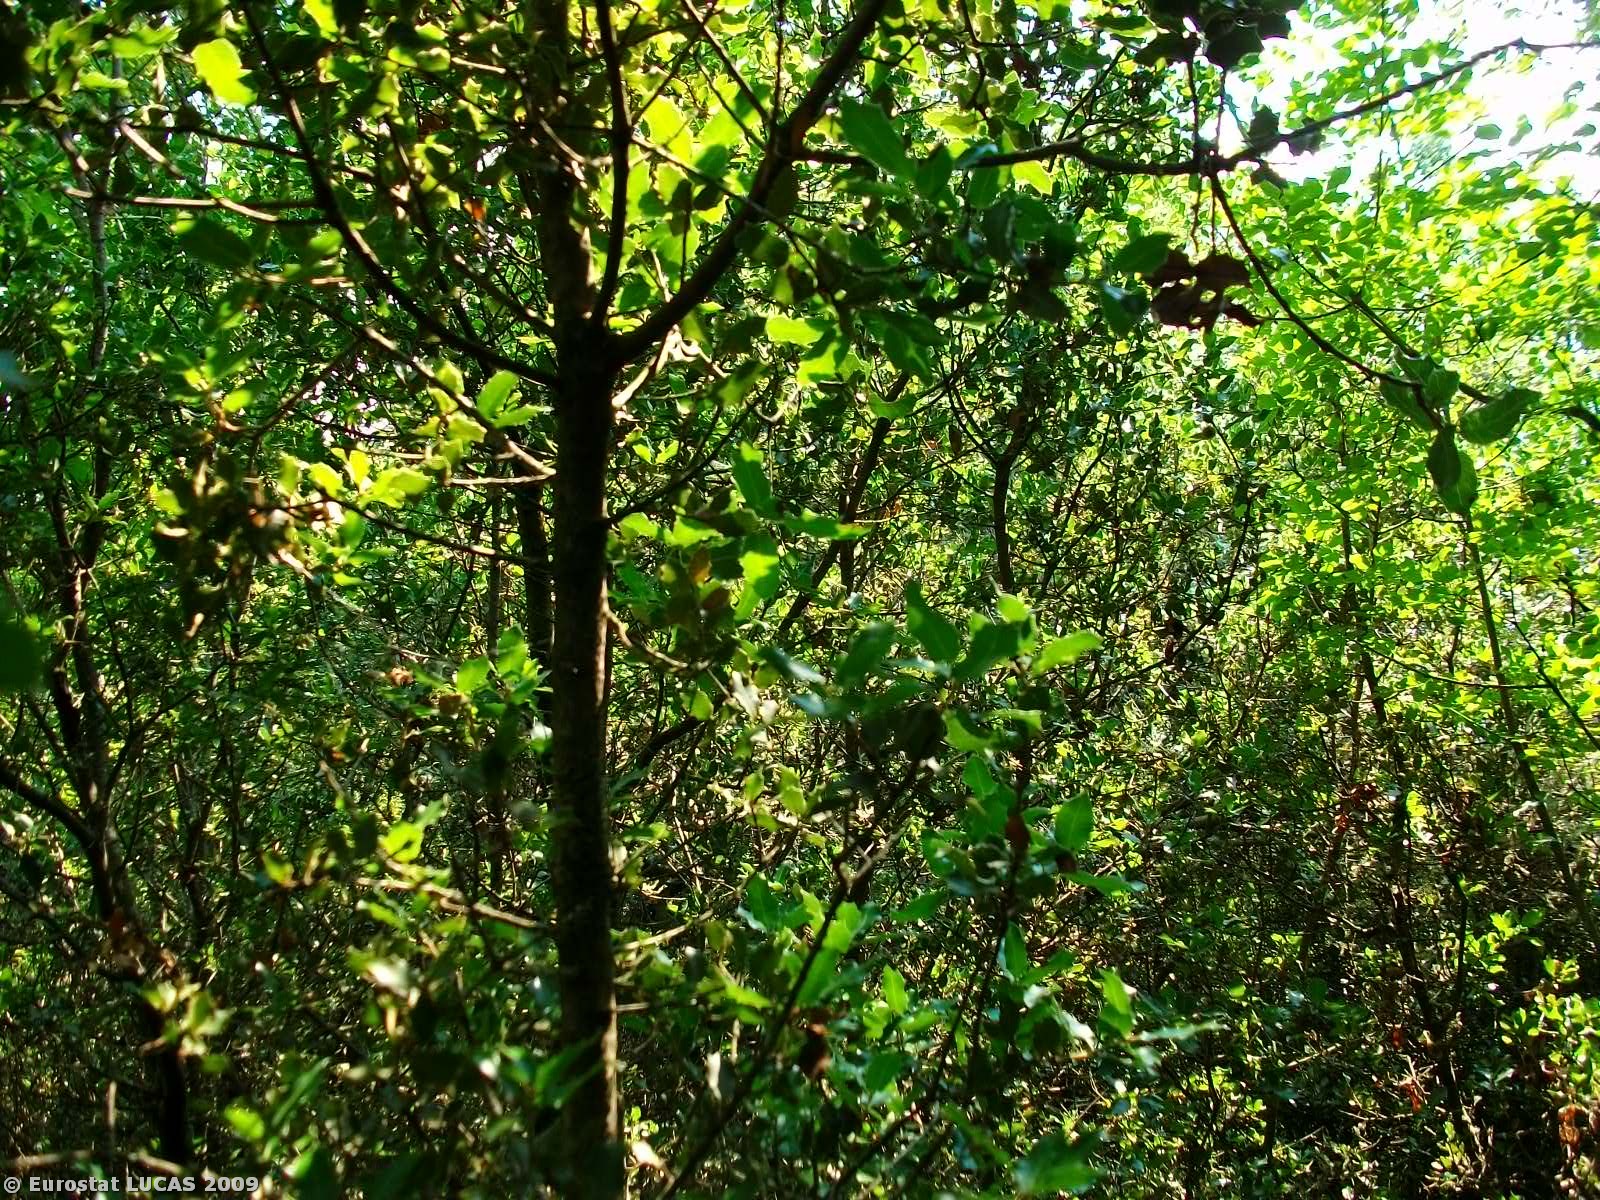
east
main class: Woodland
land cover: Broadleaved woodland
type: mesophytic deciduous forest
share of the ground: > 75 %
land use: Forestry
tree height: > 5 m
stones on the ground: 10 - 25 %
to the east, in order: Broadleaved woodland; Tracks; Broadleaved woodland; Tracks; Shrubland with sparse tree cover
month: July
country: GR
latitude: 41.0560
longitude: 24.4904
